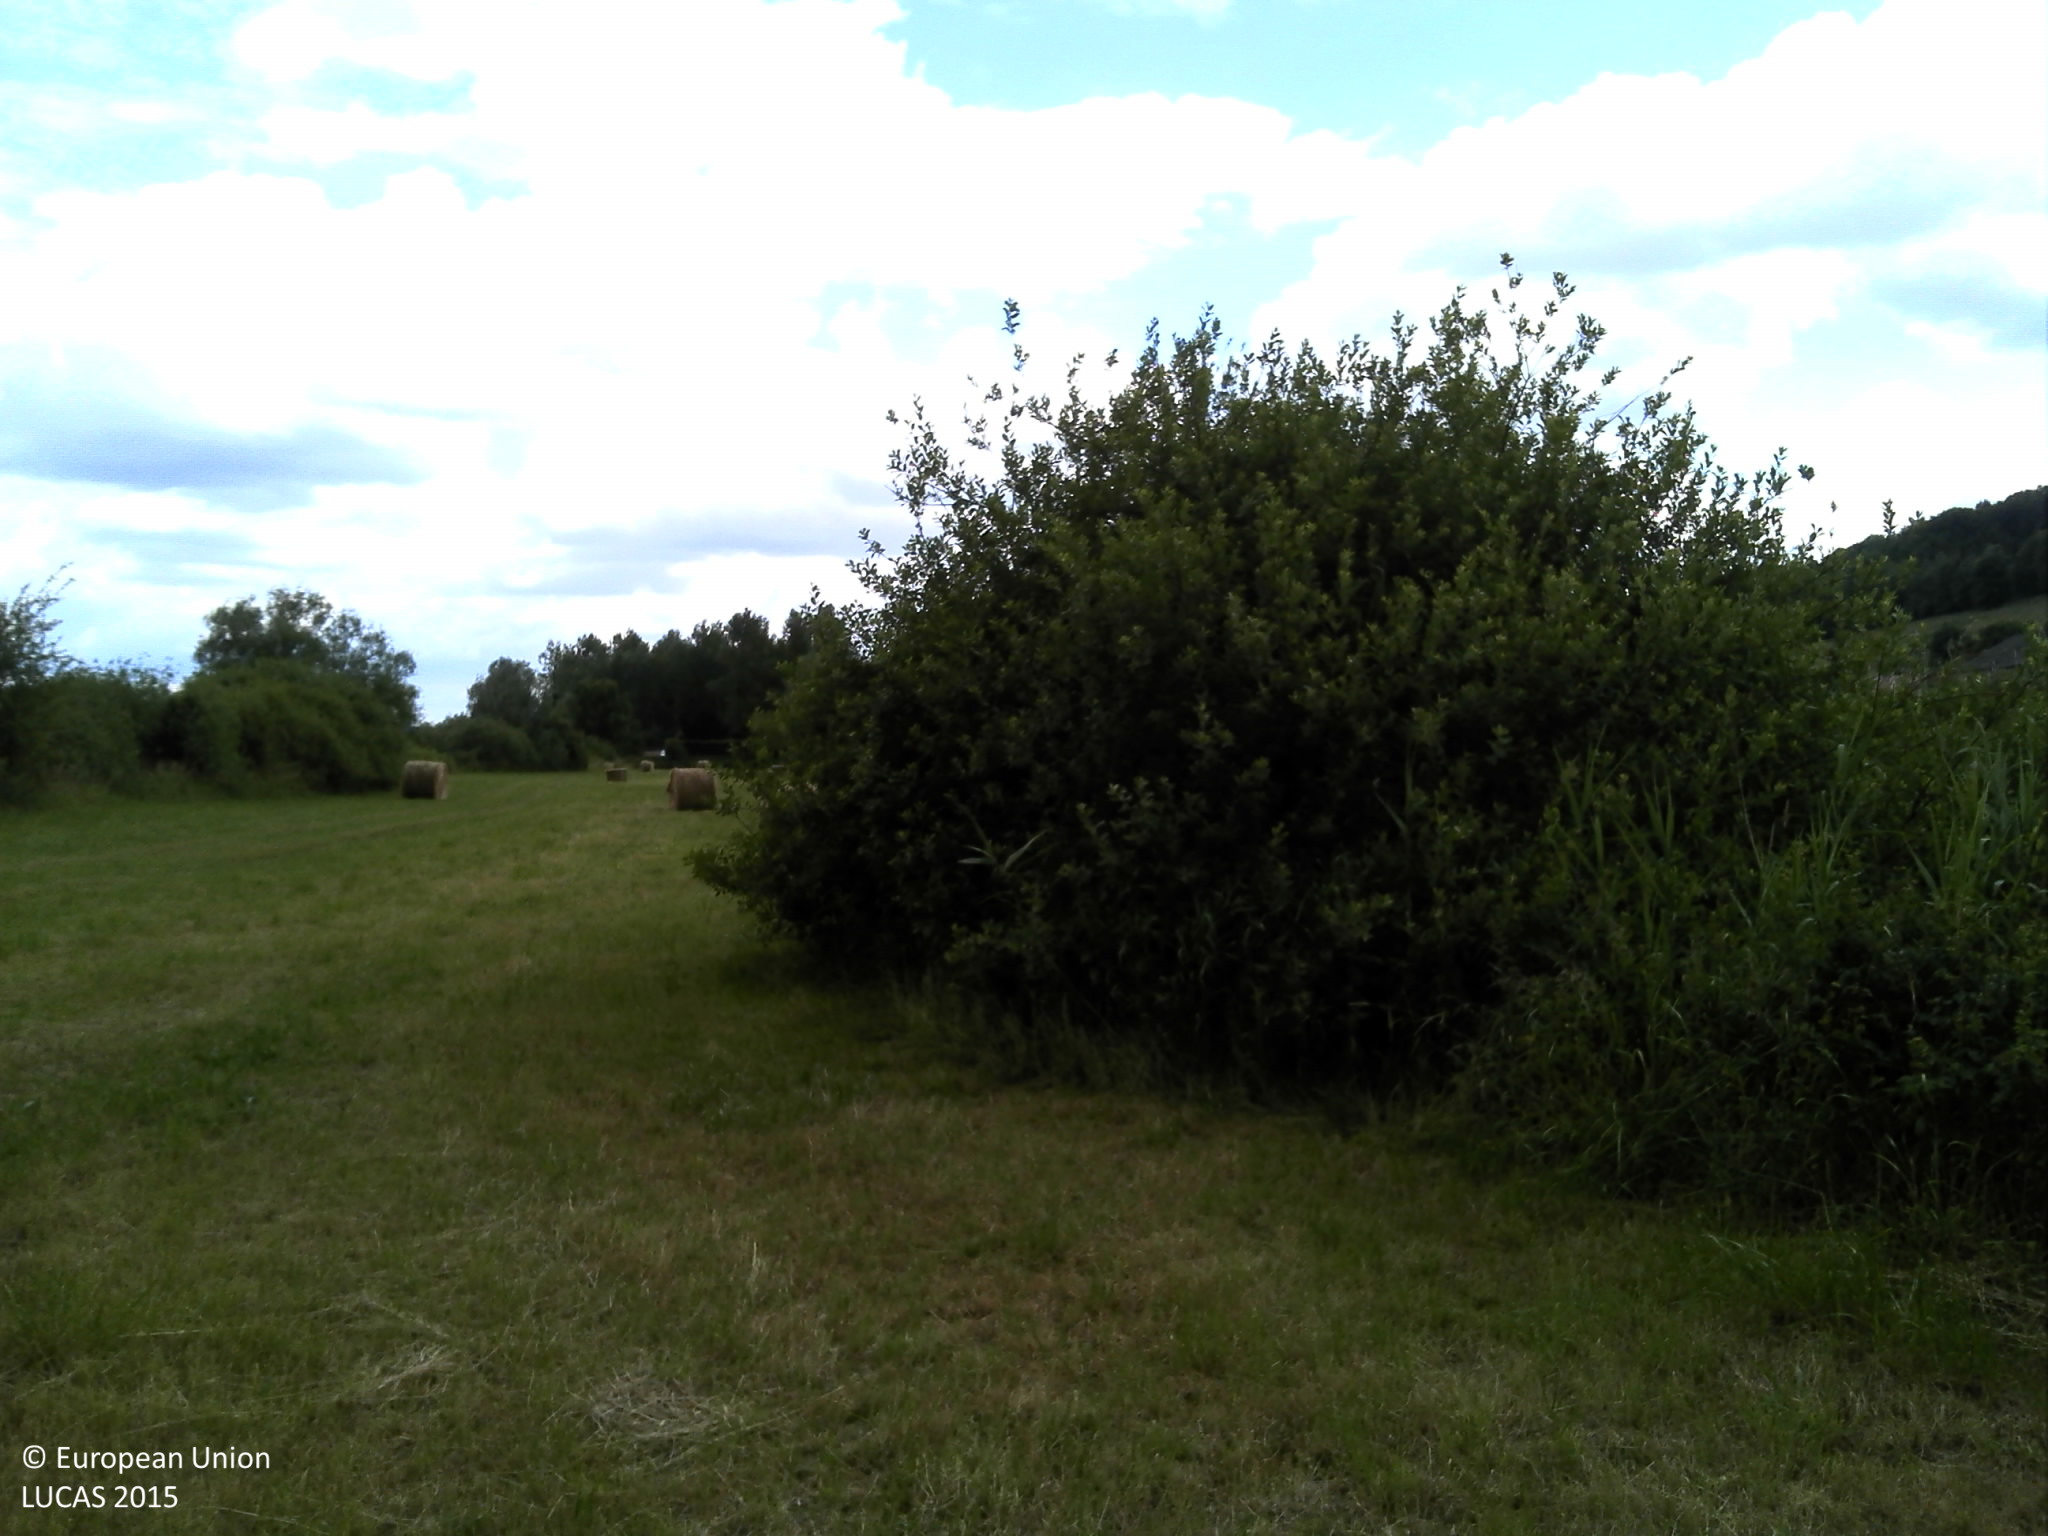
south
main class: Grassland
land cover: Grassland without tree/shrub cover
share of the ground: > 75 %
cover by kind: herbaceous plants 100 %
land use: Agriculture (excluding fallow land and kitchen gardens)
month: June
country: FR
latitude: 49.6346
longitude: 4.8325
